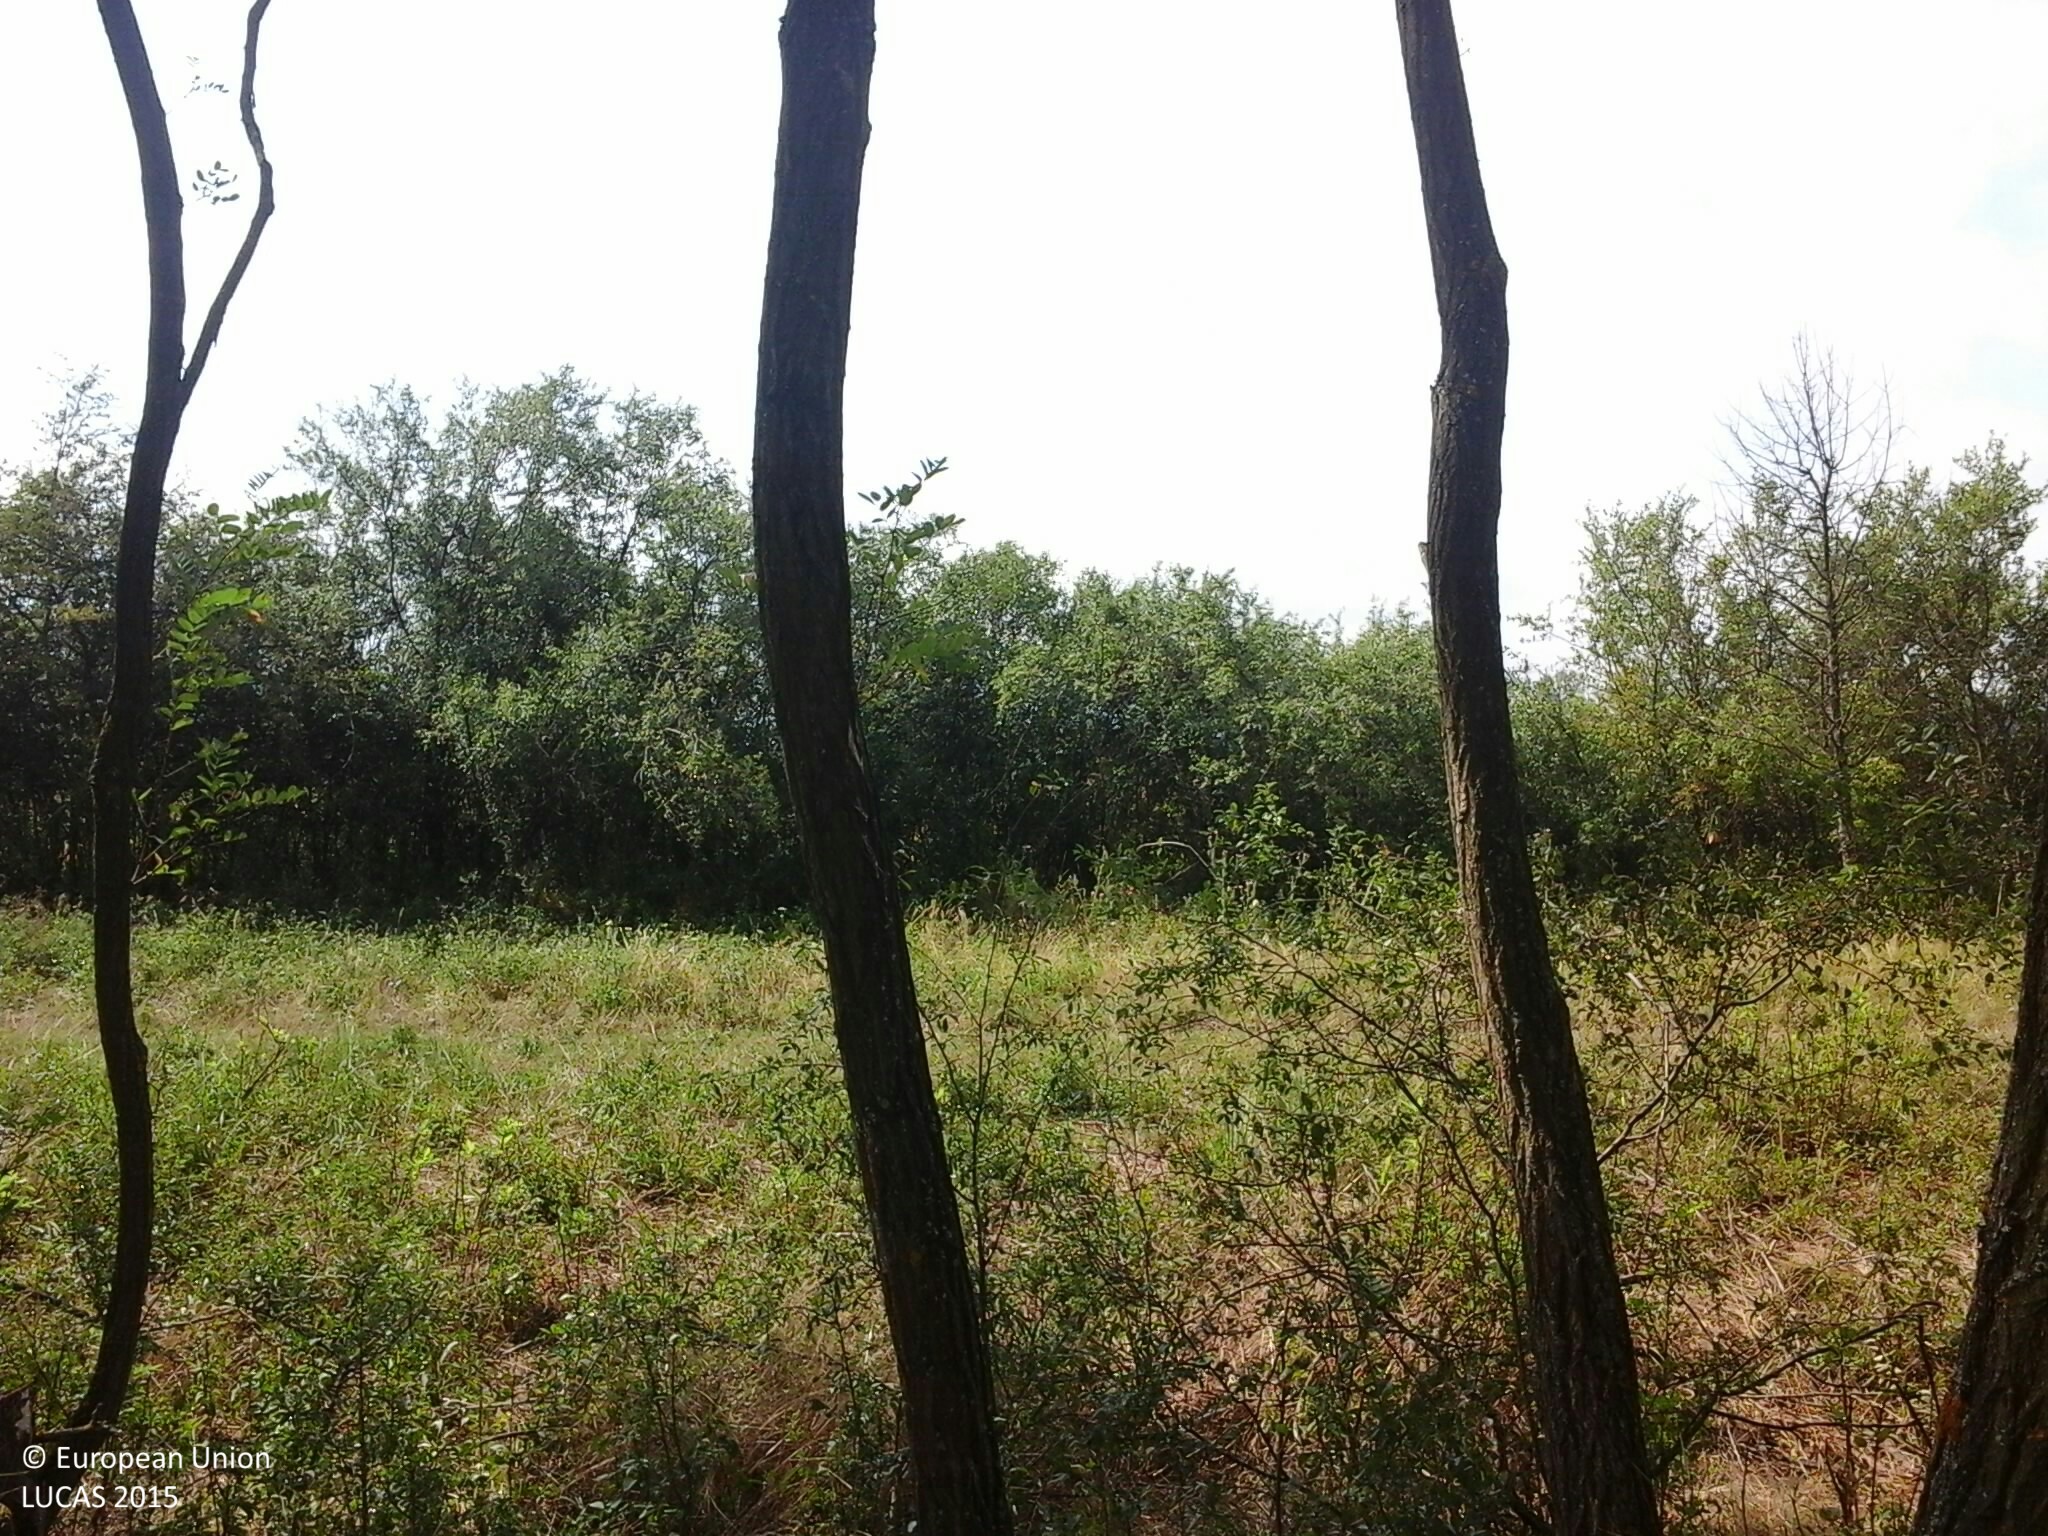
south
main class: Woodland
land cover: Broadleaved woodland
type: exotic forest
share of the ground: > 75 %
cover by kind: broadleaved forest trees 85 %, shrubs 10 %, herbaceous plants 5 %
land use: Forestry
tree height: > 5 m
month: July
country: HU
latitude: 48.2120
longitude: 22.3997
